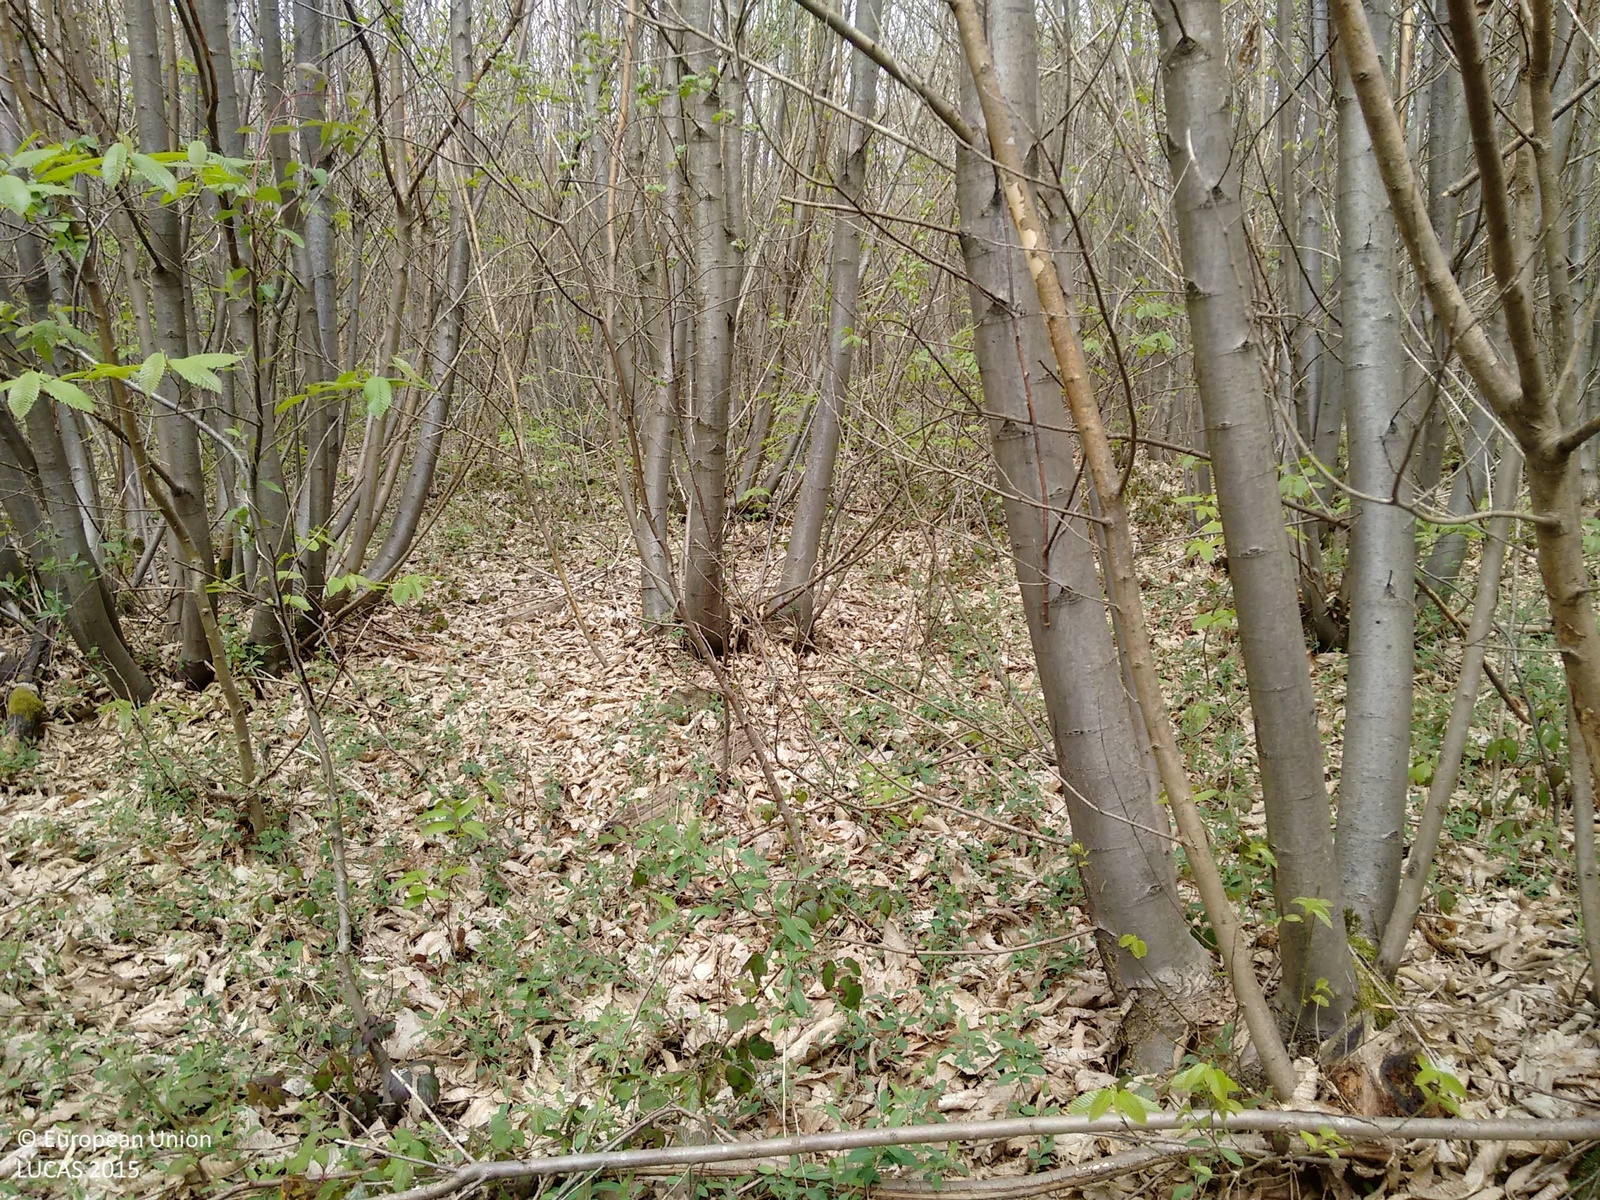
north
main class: Woodland
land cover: Broadleaved woodland
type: mesophytic deciduous forest
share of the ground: > 75 %
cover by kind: broadleaved forest trees 100 %
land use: Forestry
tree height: > 5 m
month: May
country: GB
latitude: 51.2272
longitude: 0.6224
